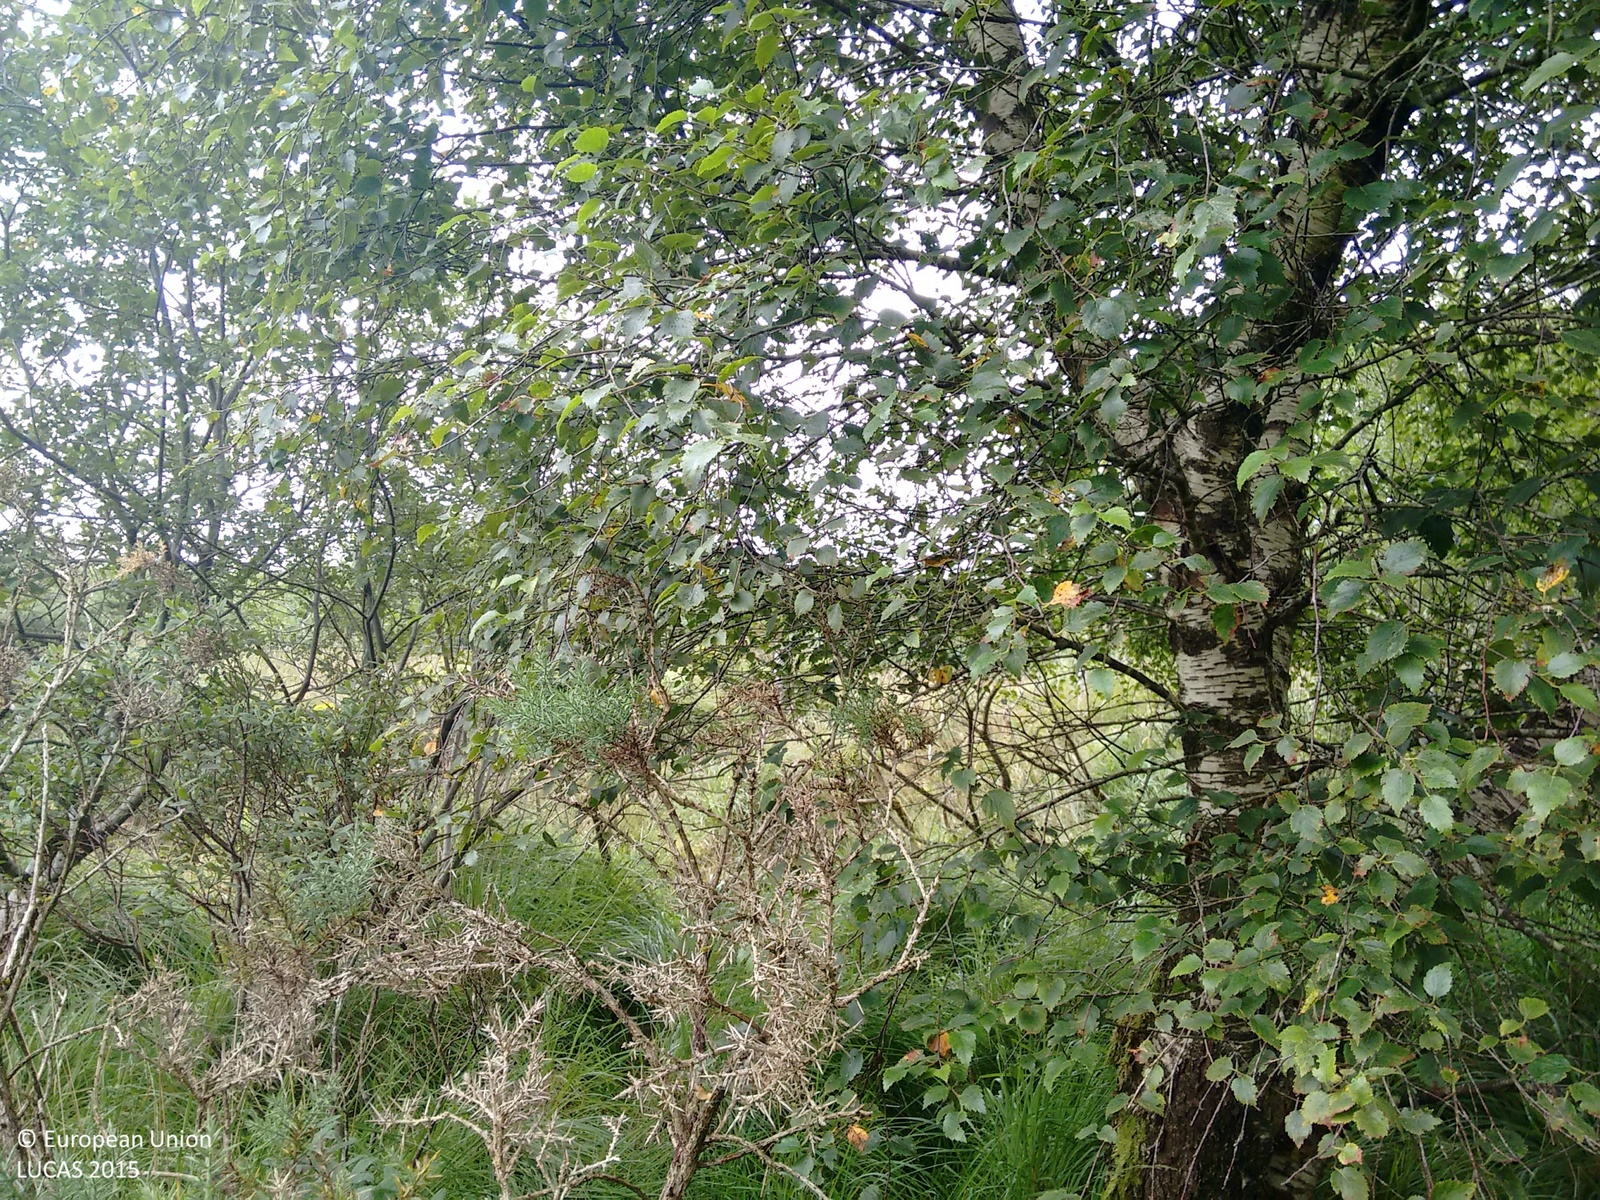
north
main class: Shrubland
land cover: Shrubland with sparse tree cover
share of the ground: > 75 %
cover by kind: shrubs 55 %, herbaceous plants 40 %, broadleaved forest trees 5 %
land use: Forestry
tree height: > 5 m
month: August
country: IE
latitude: 51.8832
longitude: -9.5120
